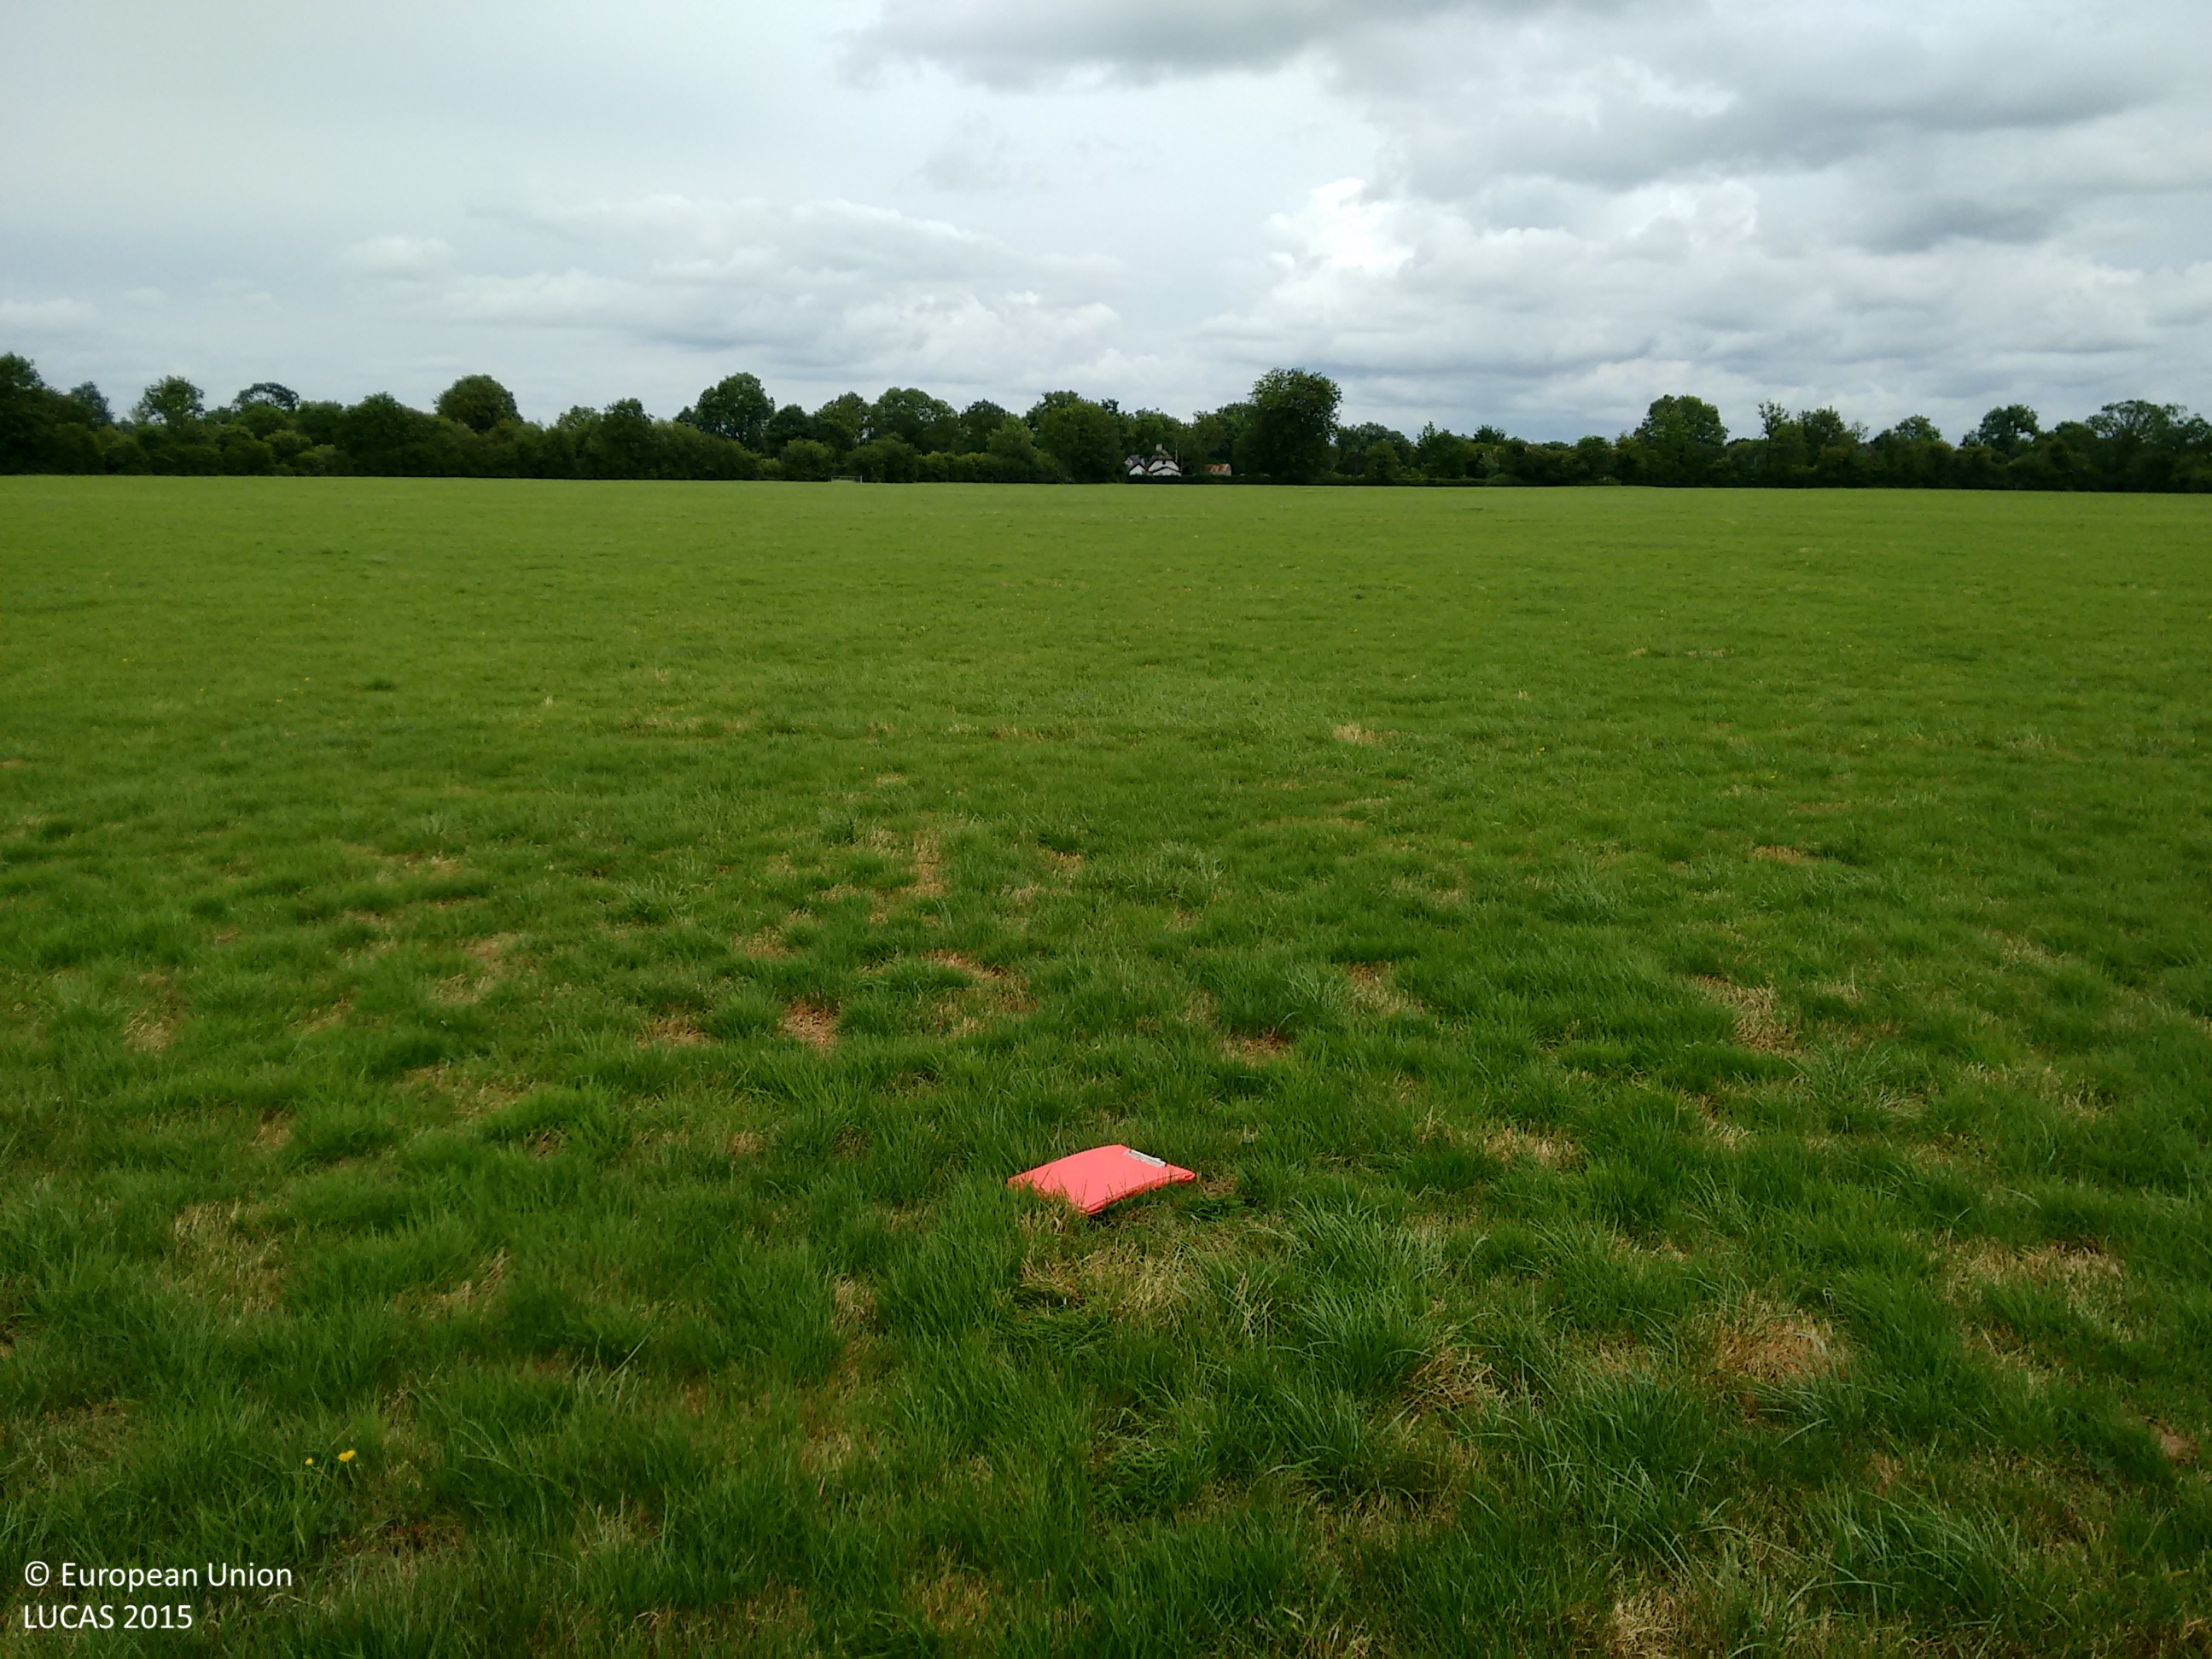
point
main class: Grassland
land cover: Grassland without tree/shrub cover
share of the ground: > 75 %
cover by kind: herbaceous plants 100 %
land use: Agriculture (excluding fallow land and kitchen gardens)
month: July
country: IE
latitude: 52.5564
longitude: -7.4895
